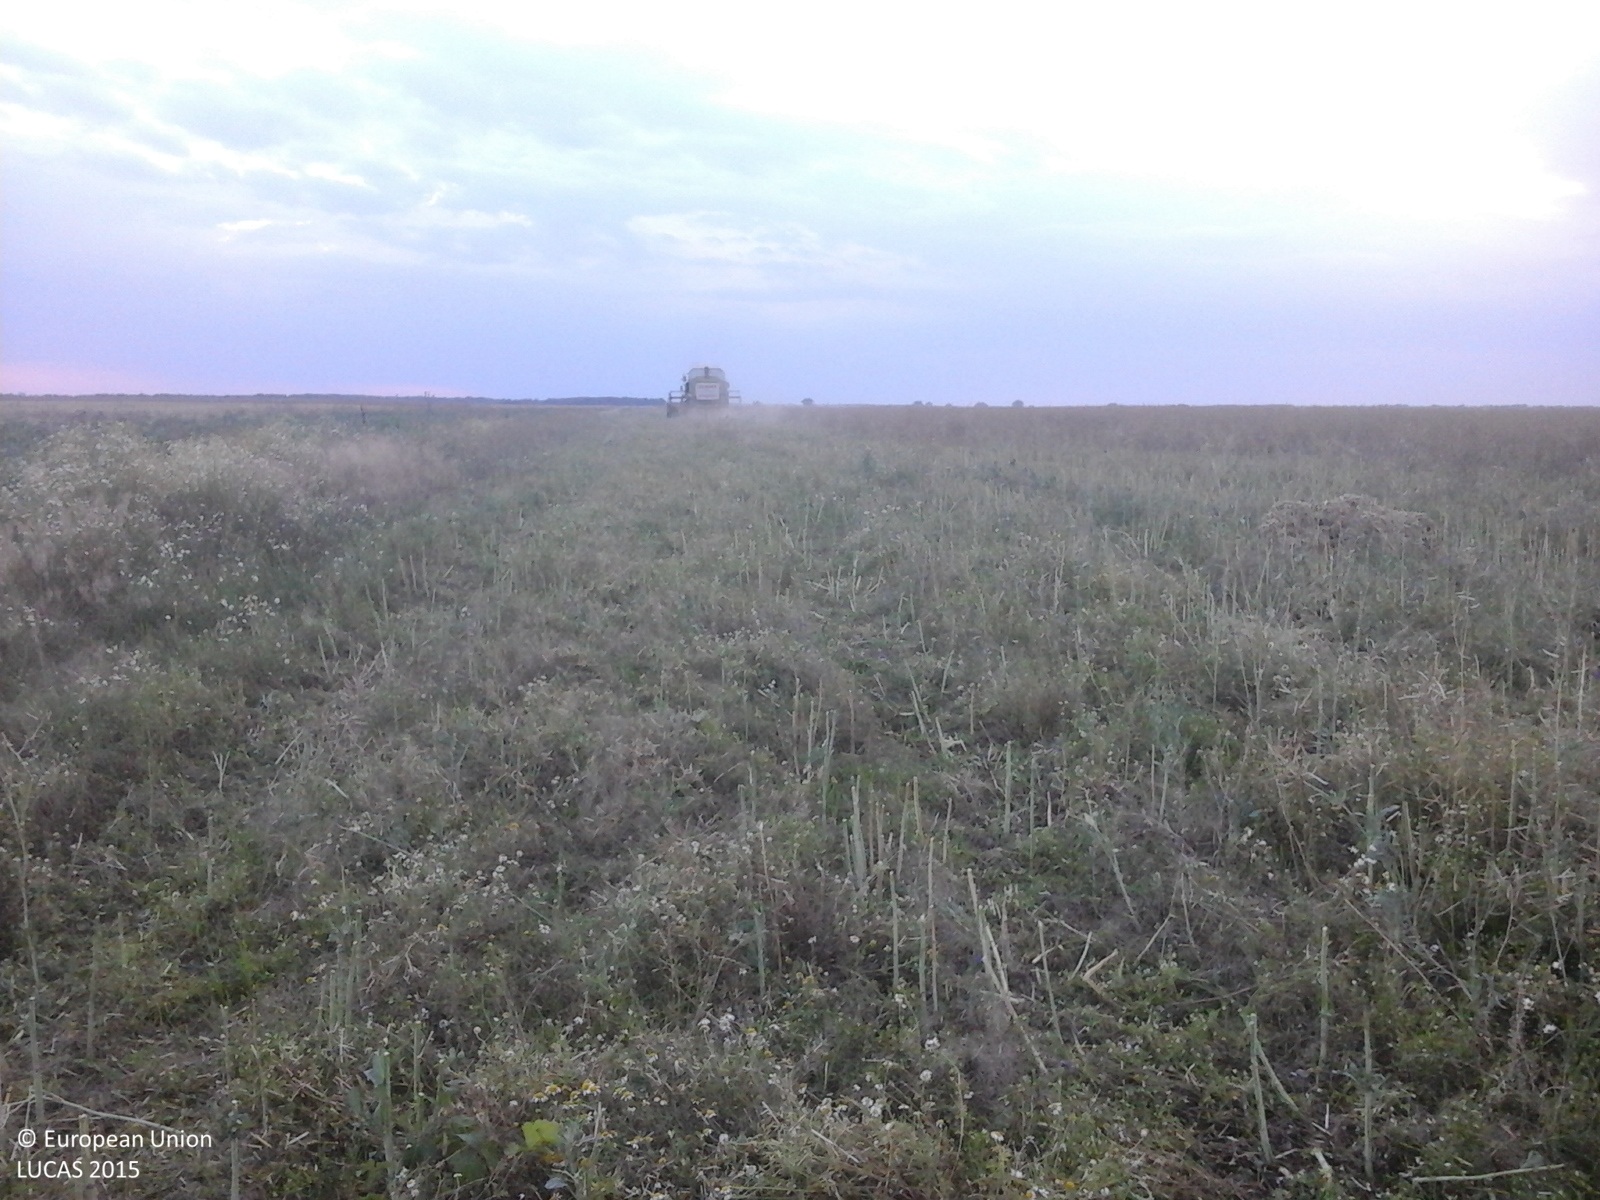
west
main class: Cropland
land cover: Rape and turnip rape
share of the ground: < 10 %
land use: Agriculture (excluding fallow land and kitchen gardens)
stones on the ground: < 10 %
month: June
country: RO
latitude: 44.1653
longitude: 26.4559
